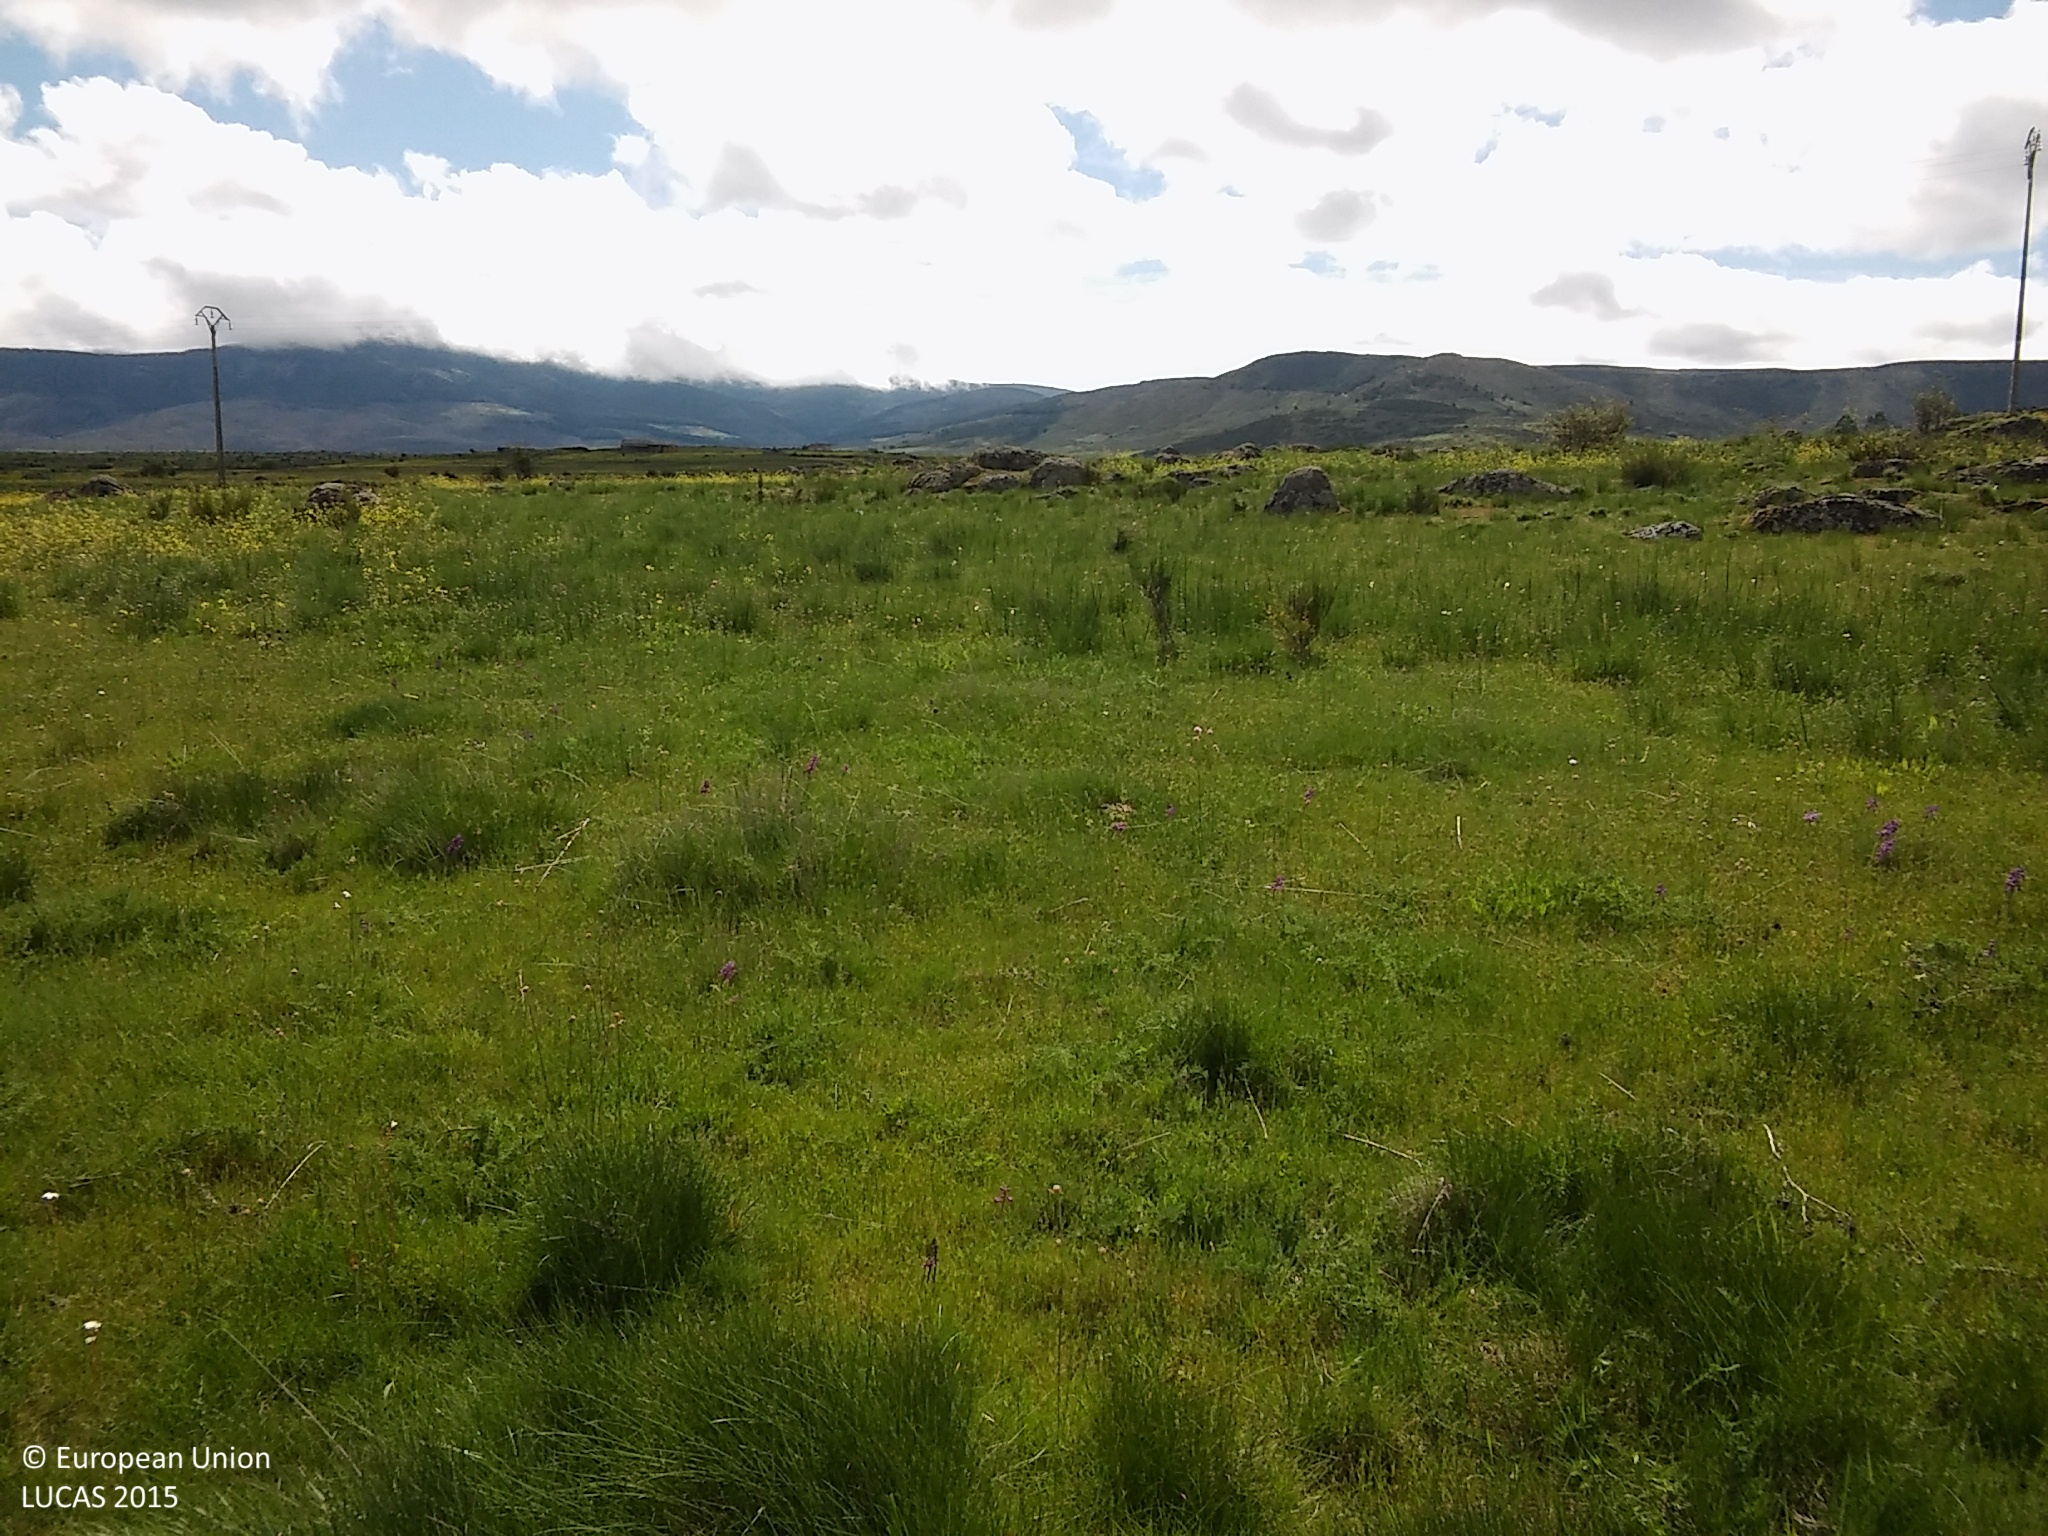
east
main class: Grassland
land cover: Grassland without tree/shrub cover
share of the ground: > 75 %
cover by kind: herbaceous plants 95 %, shrubs 5 %
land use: Agriculture (excluding fallow land and kitchen gardens)
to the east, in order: Grassland without tree/shrub cover; Rock outcrops; Grassland without tree/shrub cover; Electric lines; Grassland with sparse tree/shrub cover; Rock outcrops; Grassland without tree/shrub cover; Grassland with sparse tree/shrub cover
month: May
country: ES
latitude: 40.9963
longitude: -4.0176
